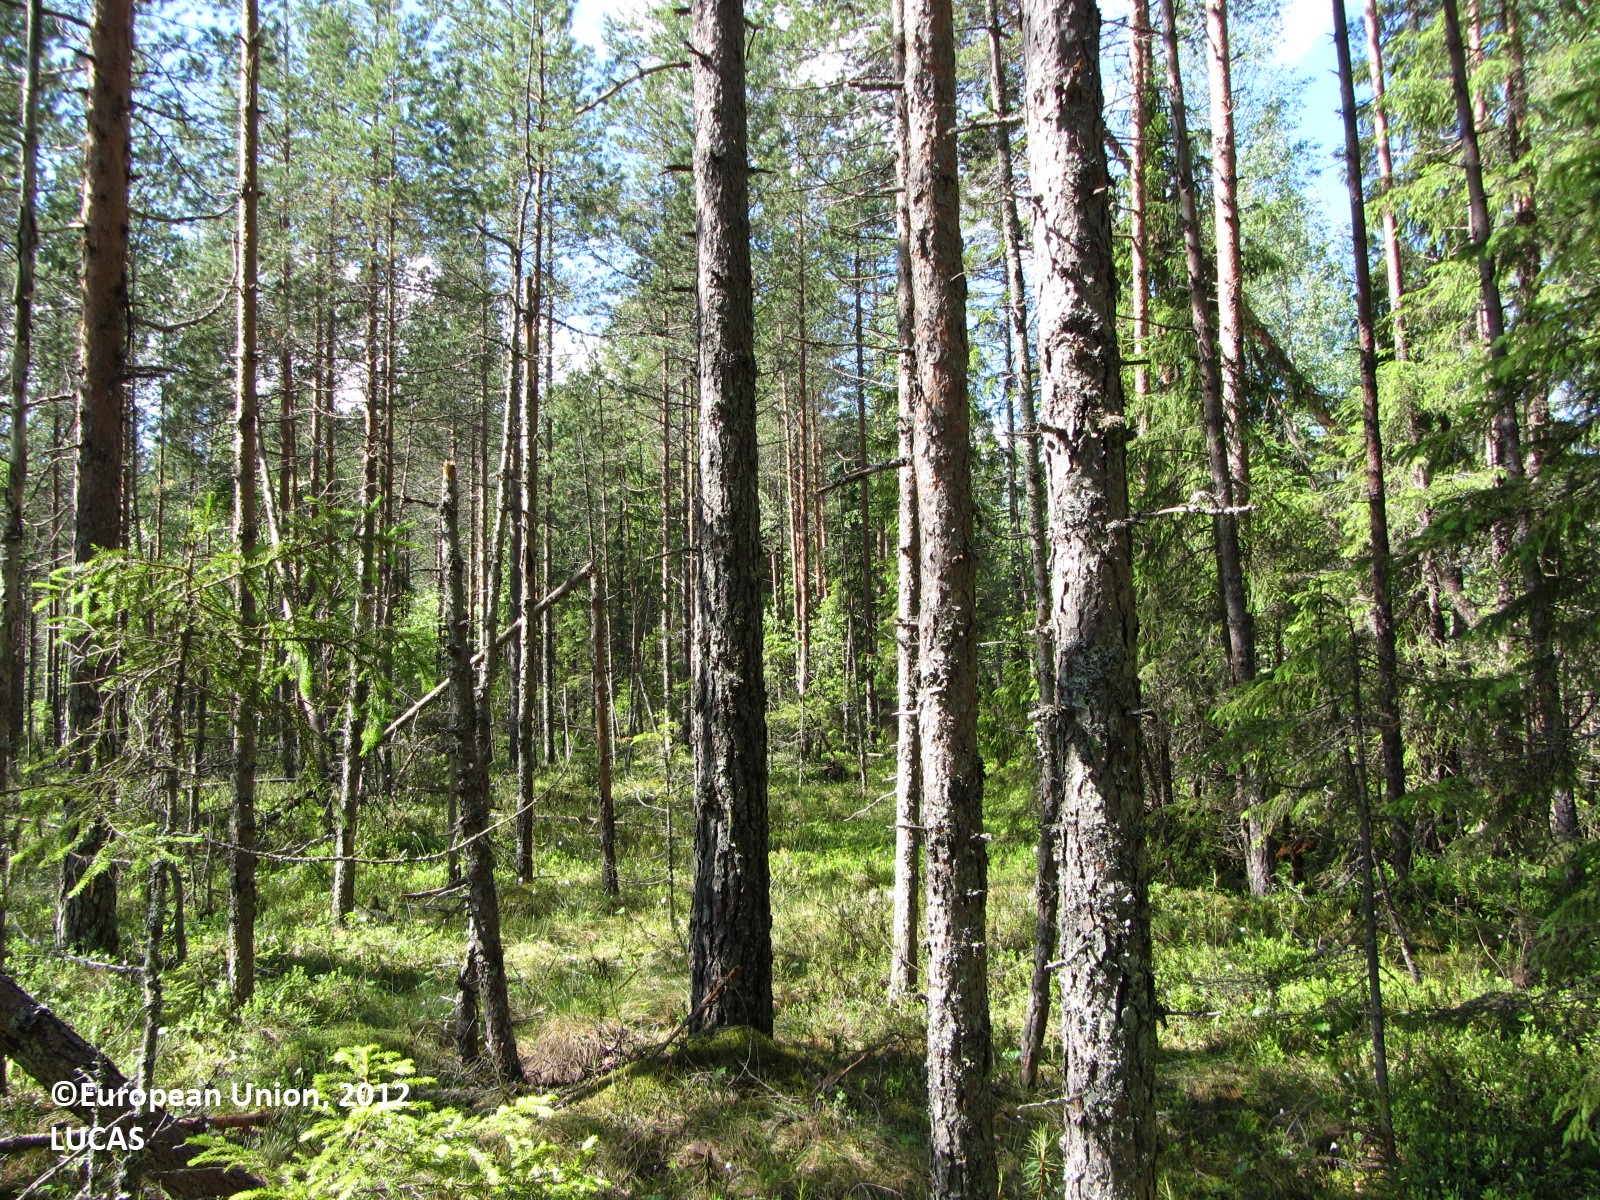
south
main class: Woodland
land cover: Pine dominated mixed woodland
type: boreal forest
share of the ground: 50 - 75 %
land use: Forestry
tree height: > 5 m
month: June
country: FI
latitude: 62.1484
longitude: 25.3658
